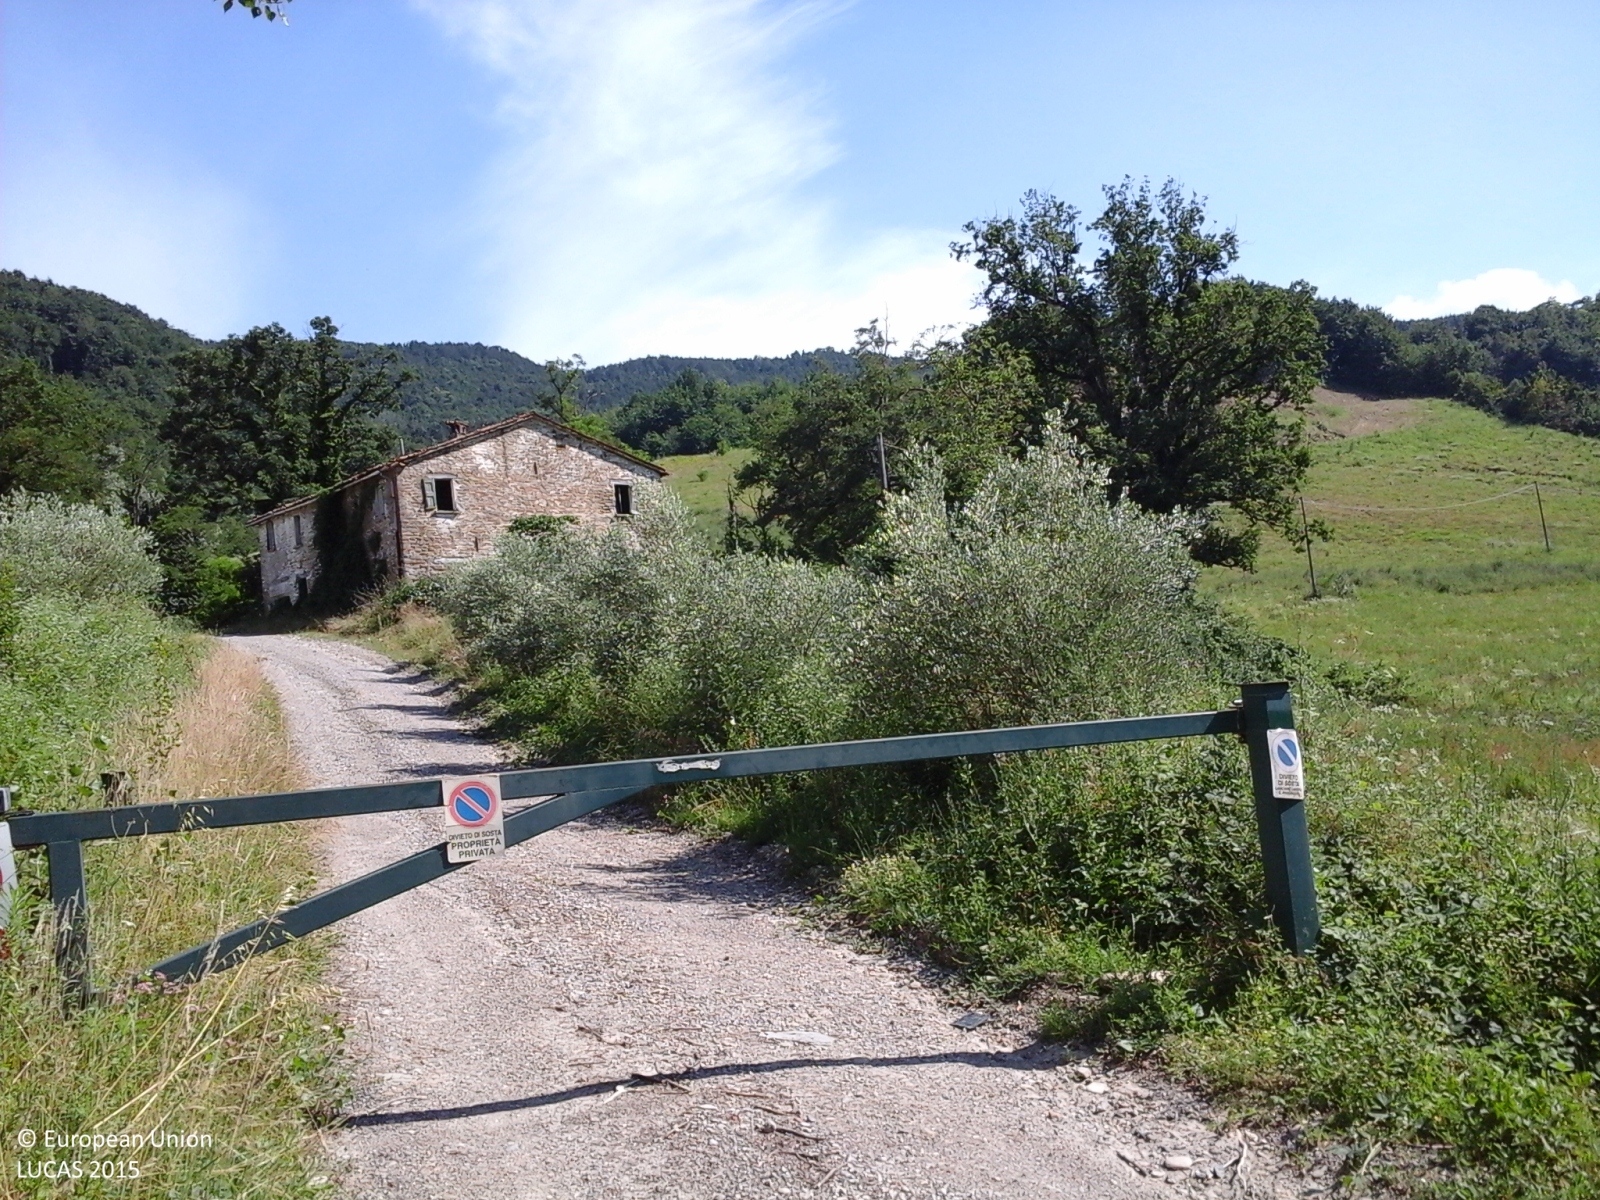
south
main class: Woodland
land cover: Pine dominated mixed woodland
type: coniferous forest of the mediterranean region
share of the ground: > 75 %
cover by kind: coniferous forest trees 60 %, broadleaved forest trees 40 %
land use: Forestry
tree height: > 5 m
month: June
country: IT
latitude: 44.2106
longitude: 11.6857
